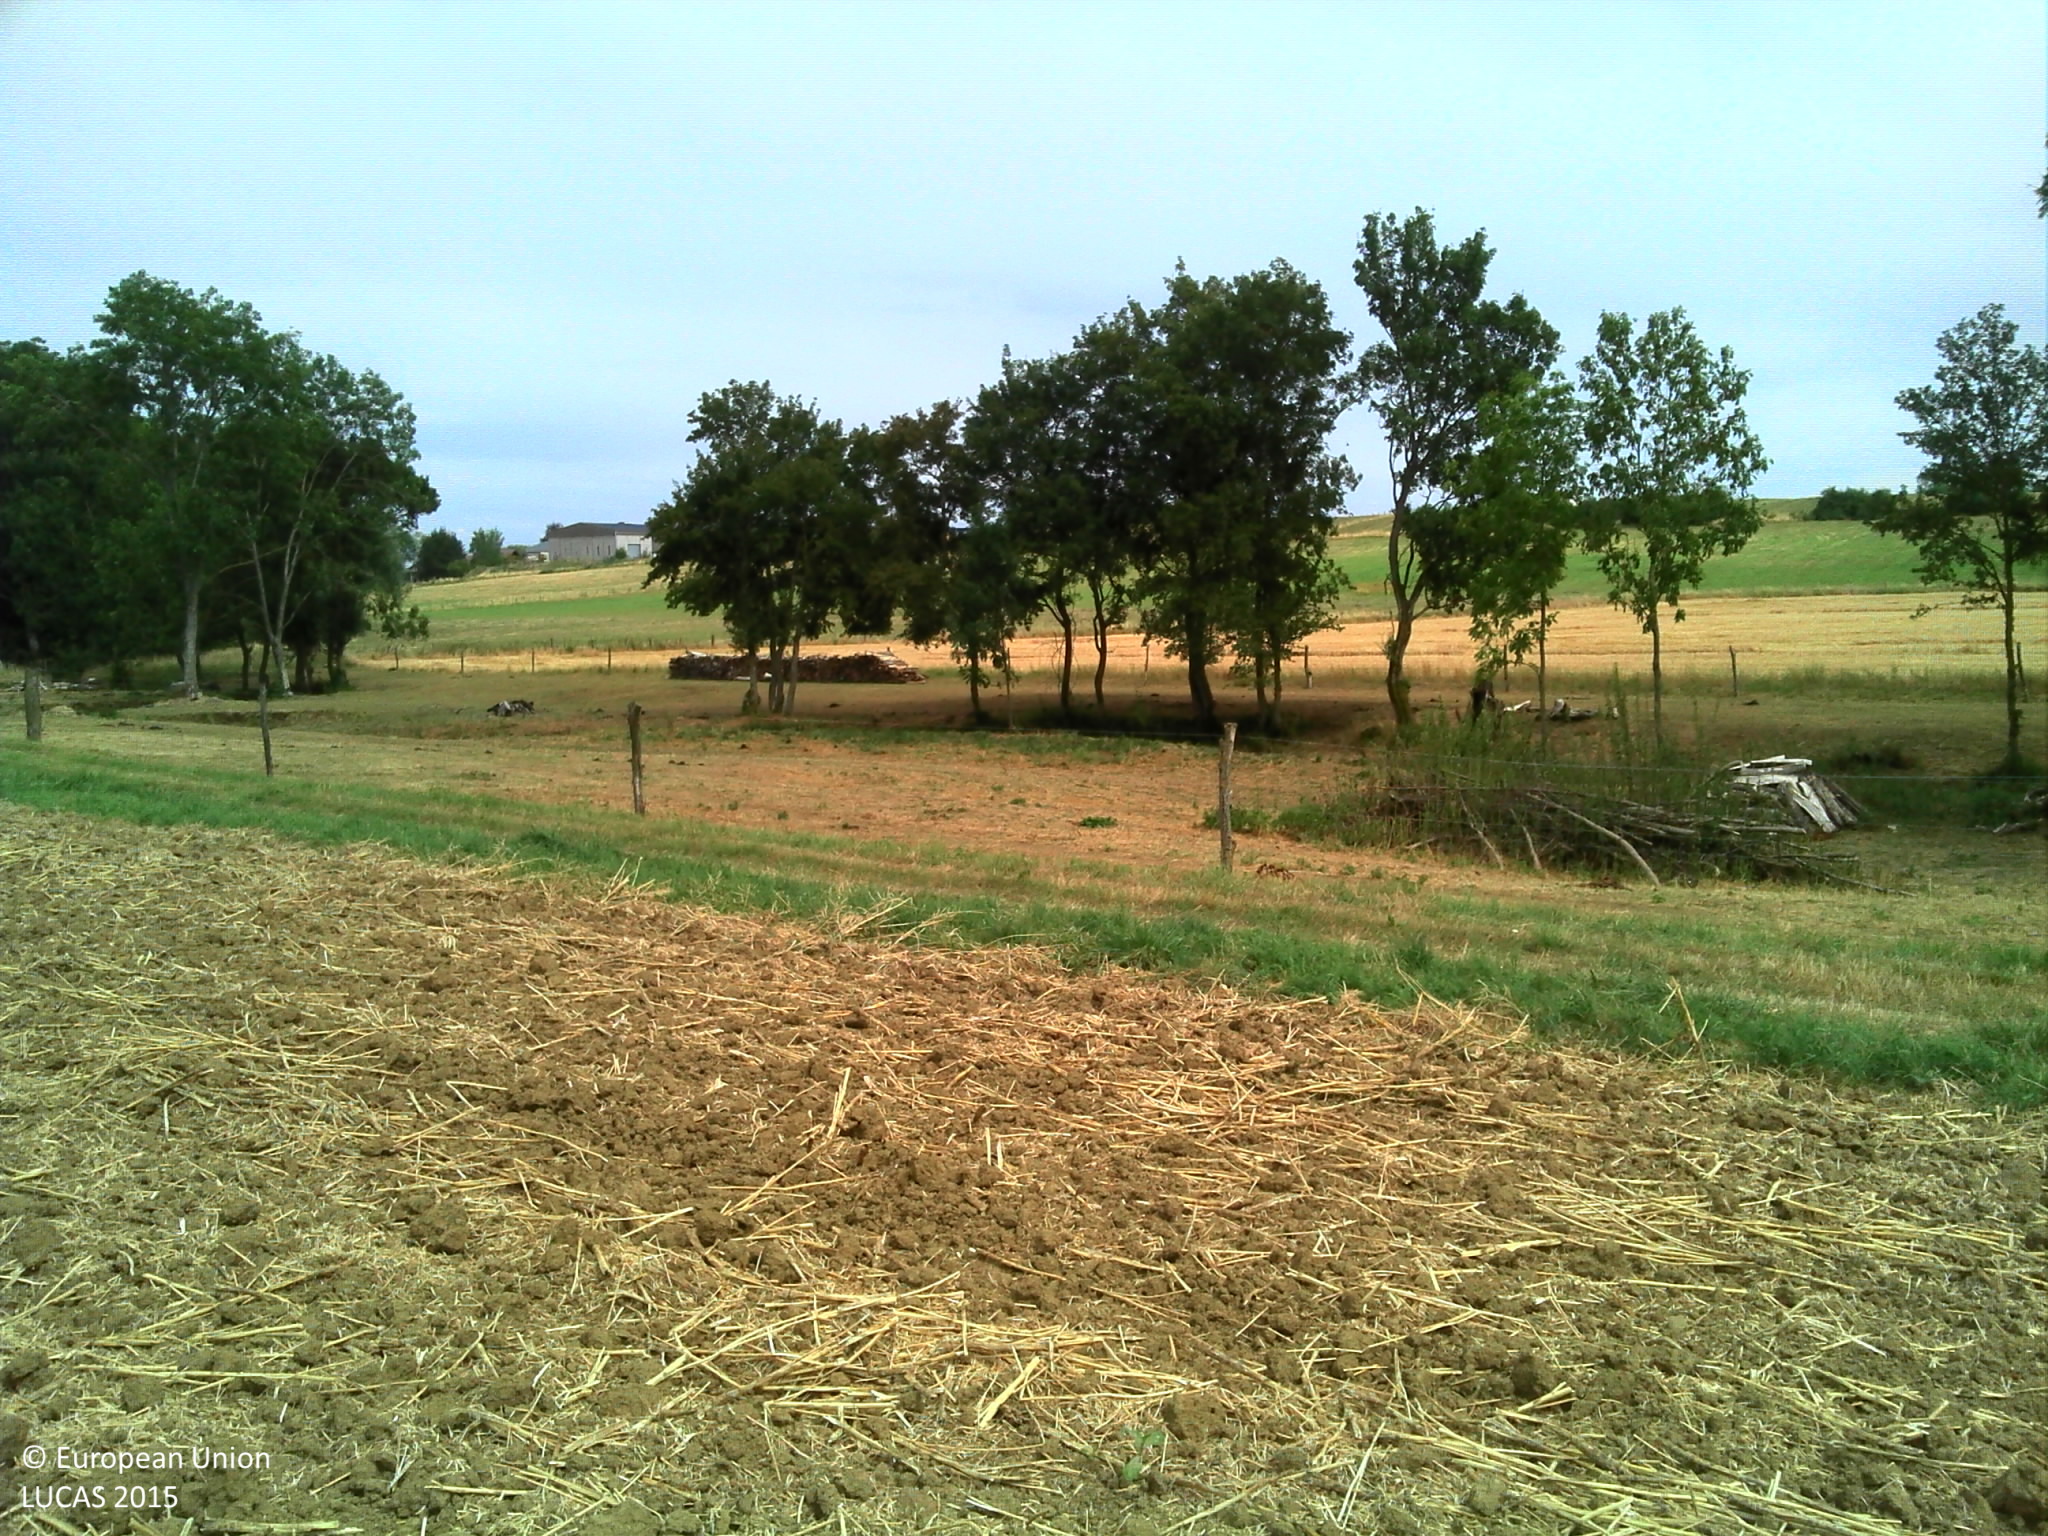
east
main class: Cropland
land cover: Rape and turnip rape
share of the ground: > 75 %
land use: Agriculture (excluding fallow land and kitchen gardens)
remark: Harvested field
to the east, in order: Rape and turnip rape; Grass margins; Tracks; Grass margins; Fences; Grassland without tree/shrub cover; Rivers and streams; Lines of trees; Grassland without tree/shrub cover; Fences; Grass margins; Common wheat; Grass margins; Fences; Grassland without tree/shrub cover
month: July
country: FR
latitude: 48.3896
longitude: 6.1245
